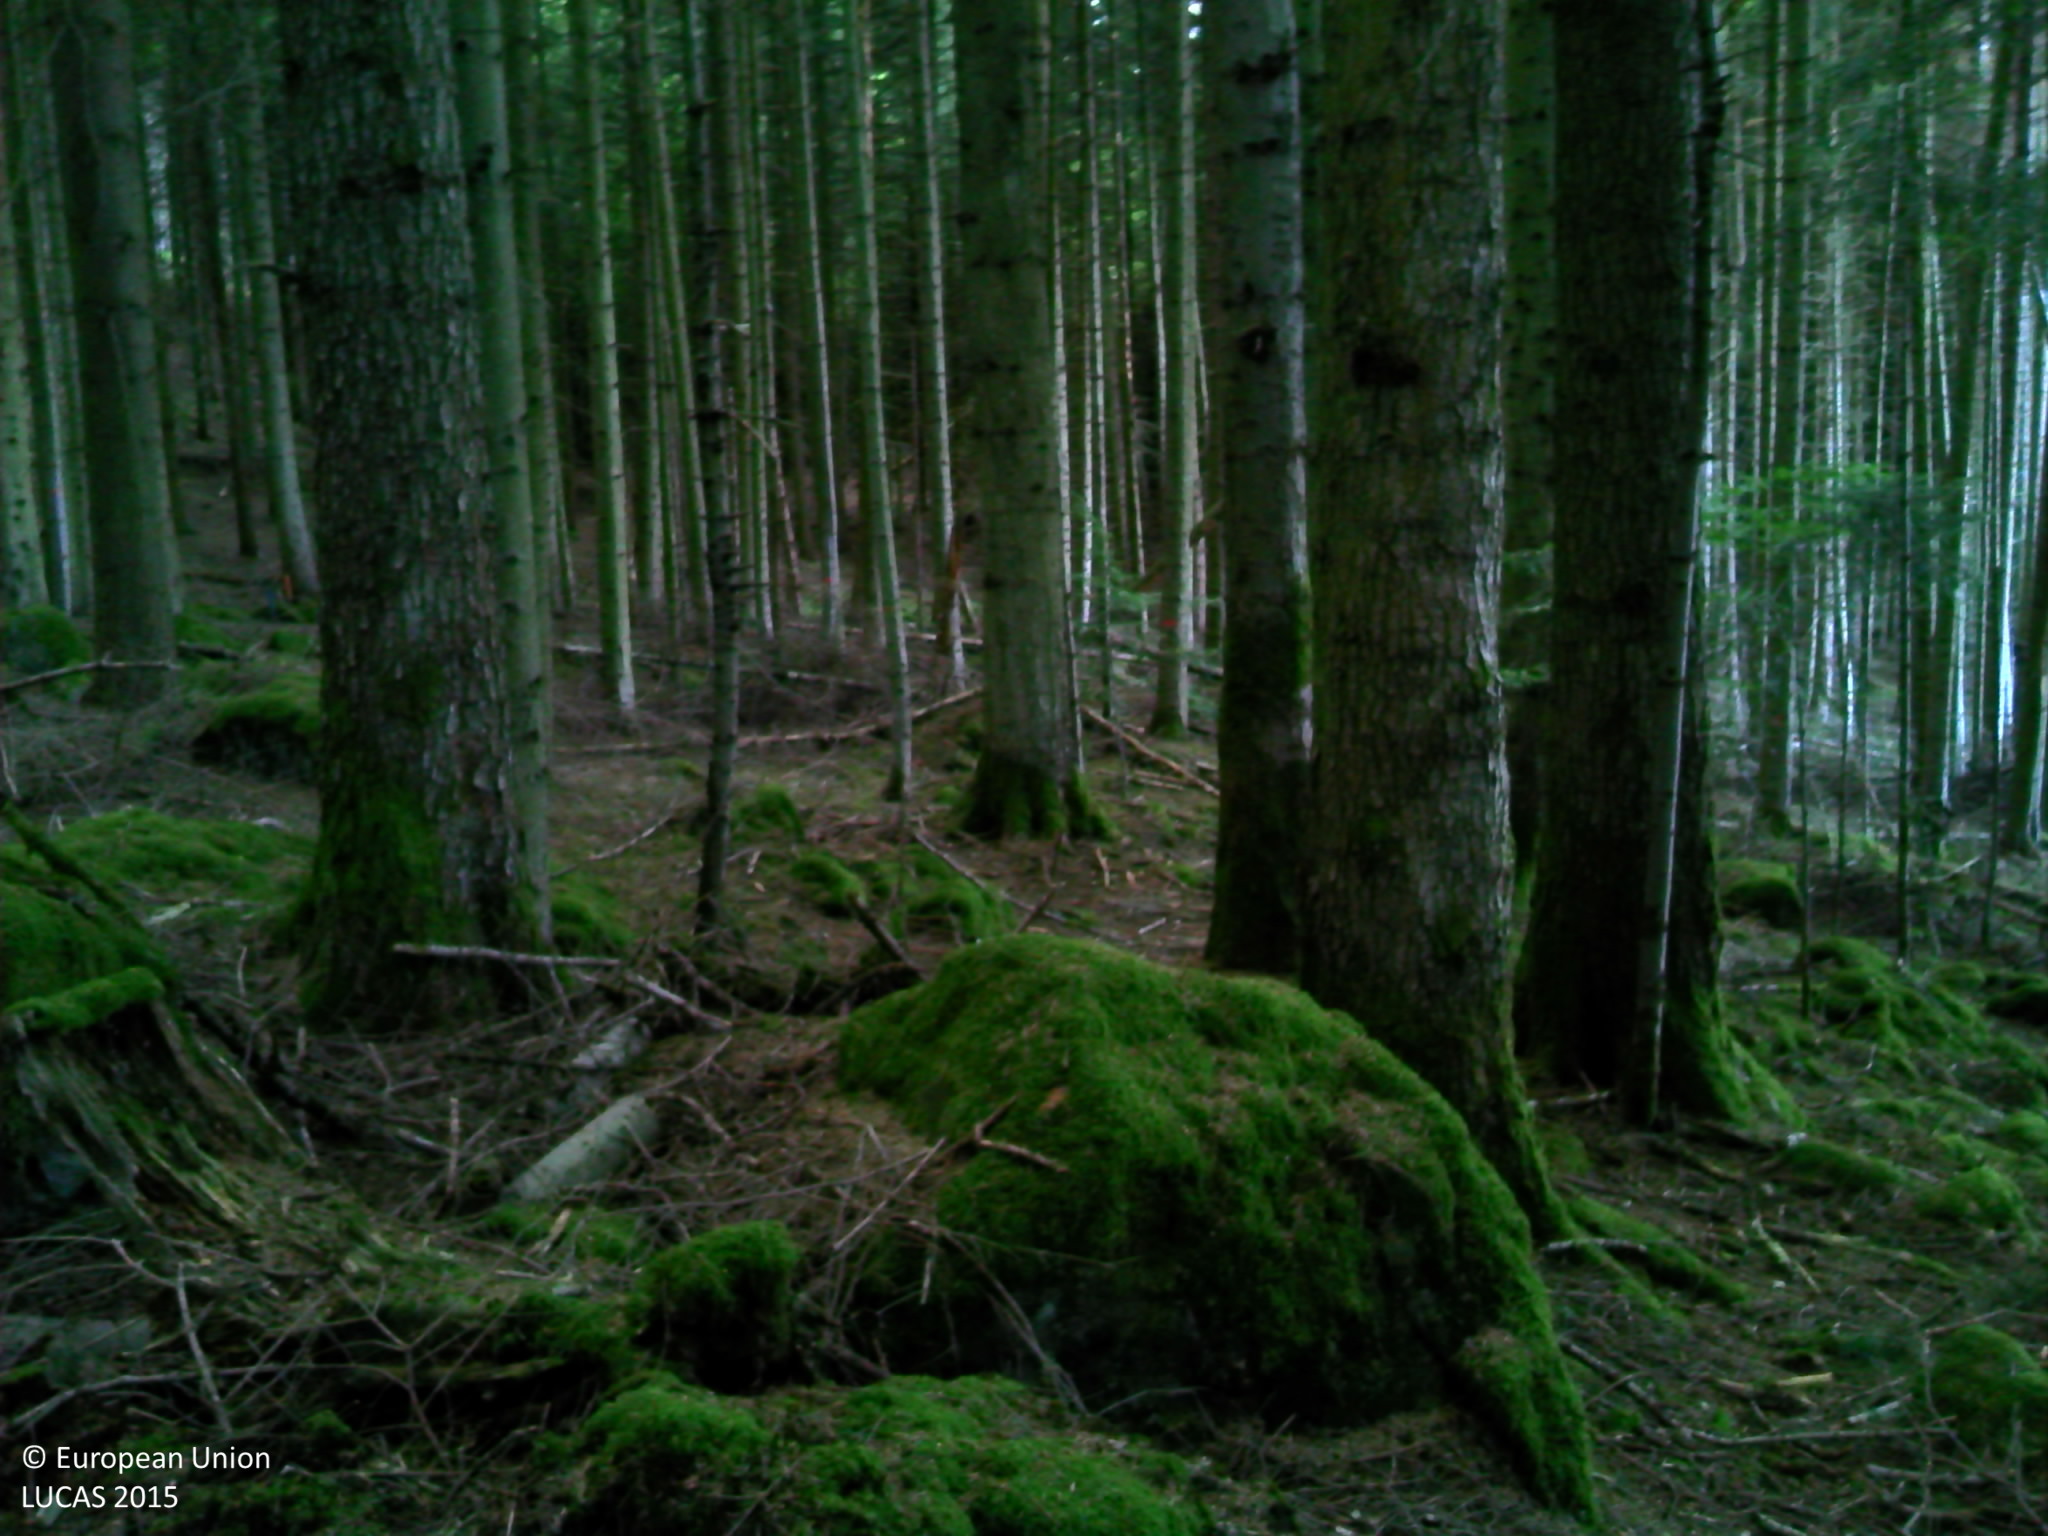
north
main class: Woodland
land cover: Spruce dominated coniferous woodland
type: alpine coniferous forest
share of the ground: > 75 %
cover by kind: coniferous forest trees 100 %
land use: Forestry
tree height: > 5 m
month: August
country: FR
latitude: 46.2273
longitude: 4.4916
